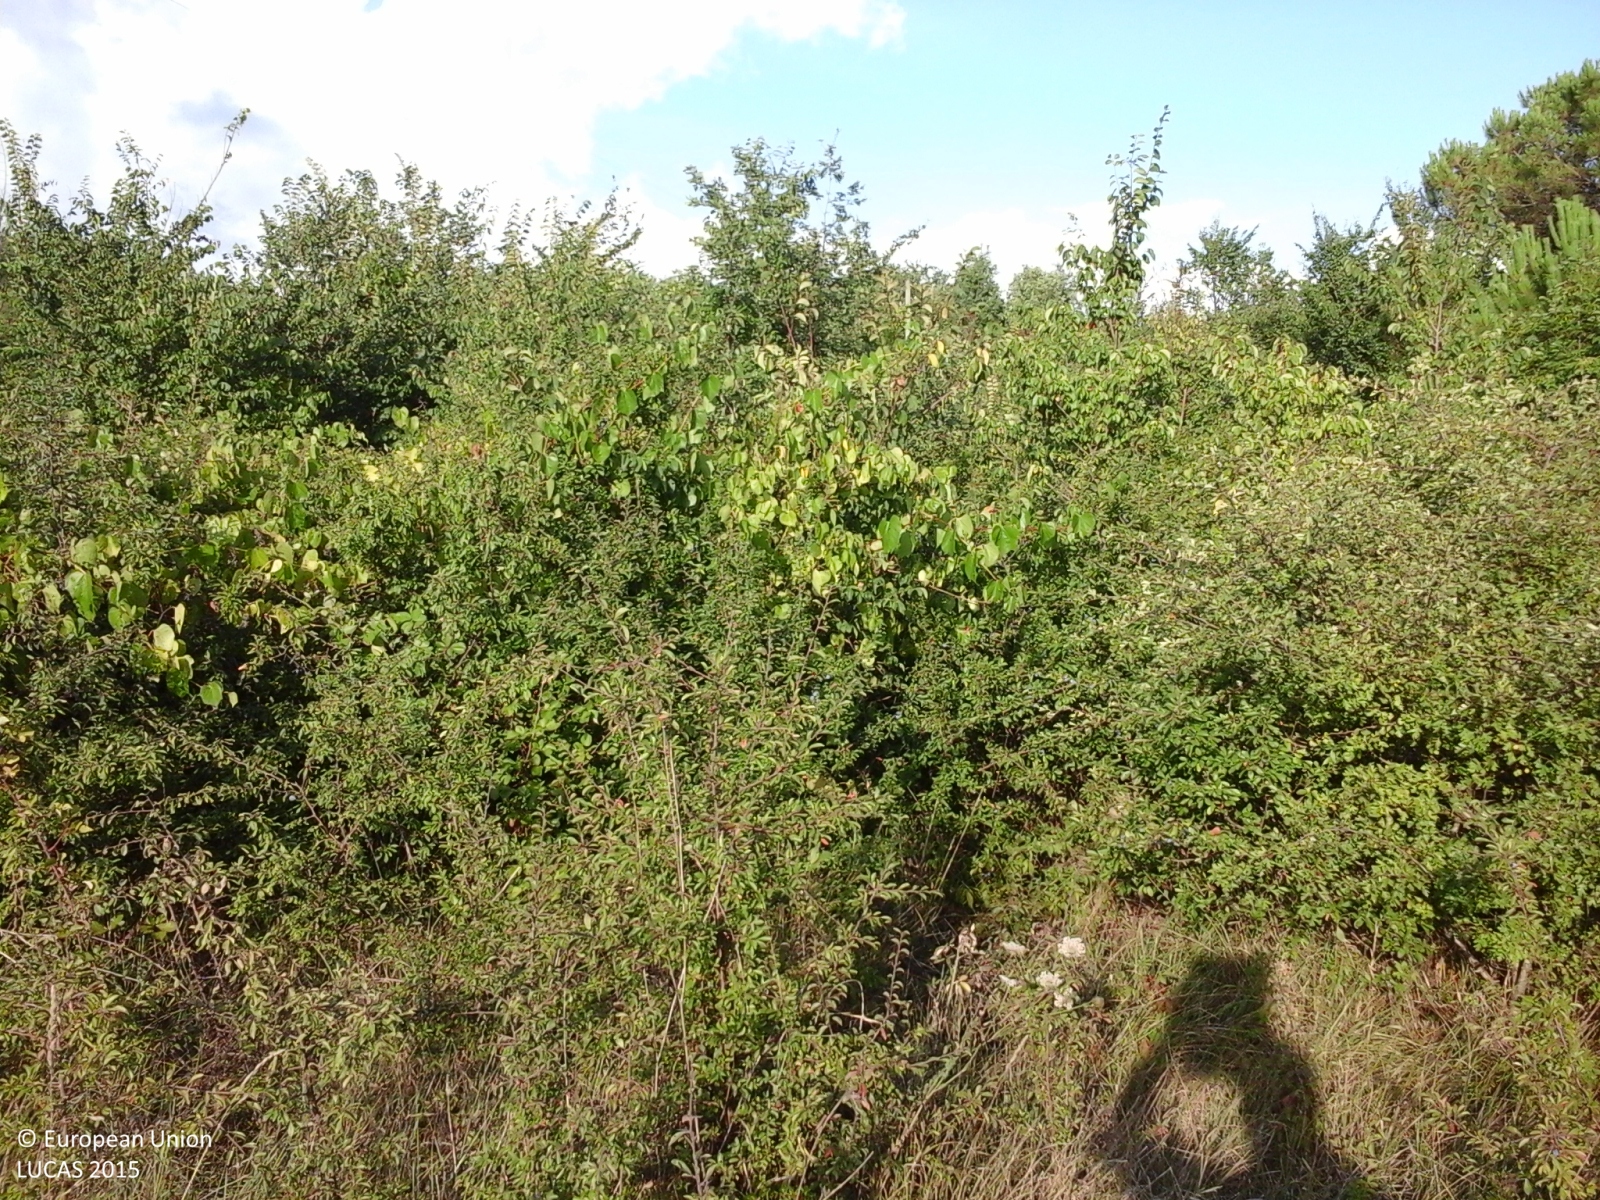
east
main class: Shrubland
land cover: Shrubland with sparse tree cover
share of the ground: > 75 %
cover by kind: shrubs 90 %, broadleaved forest trees 5 %, herbaceous plants 5 %
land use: Semi-natural and natural areas not in use
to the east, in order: Shrubland with sparse tree cover; Broadleaved woodland; Electric lines; Broadleaved woodland; Electric lines; Broadleaved woodland; Grassland without tree/shrub cover; Abandoned hedges; Grassland without tree/shrub cover; Single bushes/trees; Grassland without tree/shrub cover
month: August
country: IT
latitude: 41.6042
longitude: 14.2923
